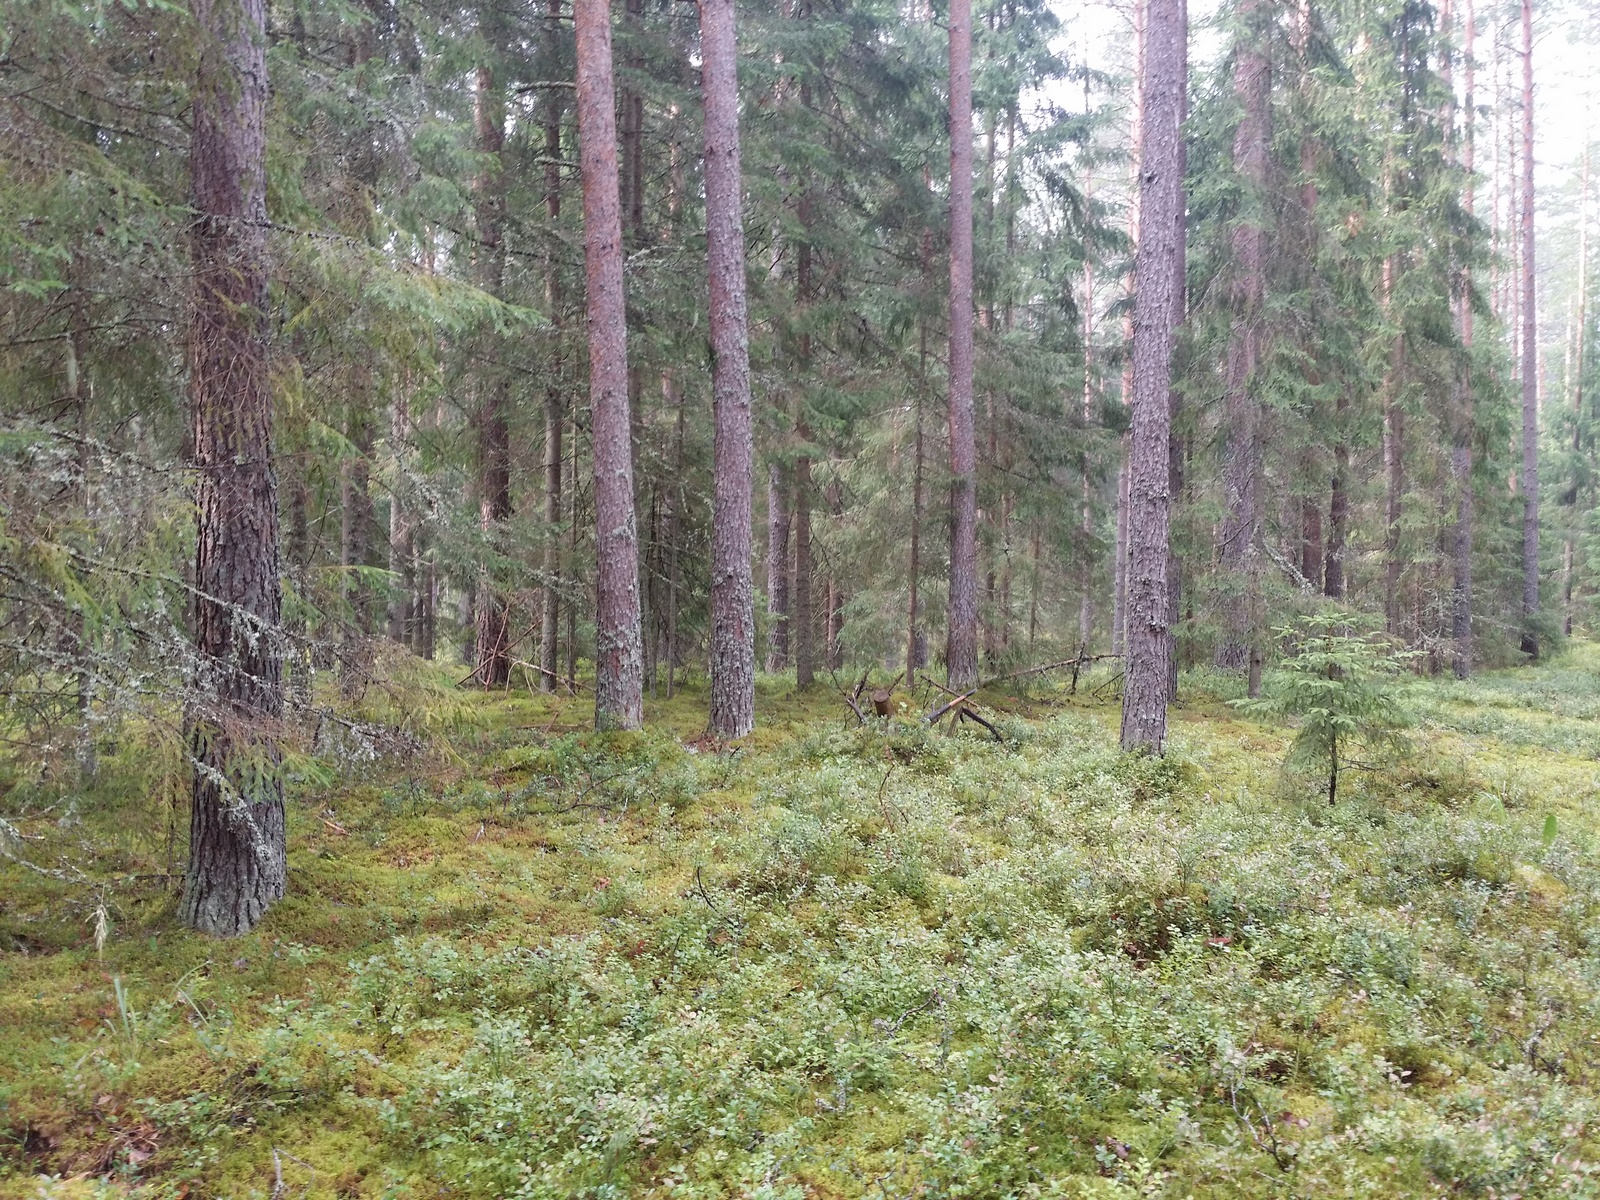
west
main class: Woodland
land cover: Other coniferous woodland
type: hemiboreal forest and nemoral coniferous forest and mixed broadleaved-coniferous forest
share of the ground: > 75 %
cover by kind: coniferous forest trees 80 %, lichens and mosses 15 %, herbaceous plants 5 %
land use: Forestry
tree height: > 5 m
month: August
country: LV
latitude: 57.4968
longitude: 26.6836
